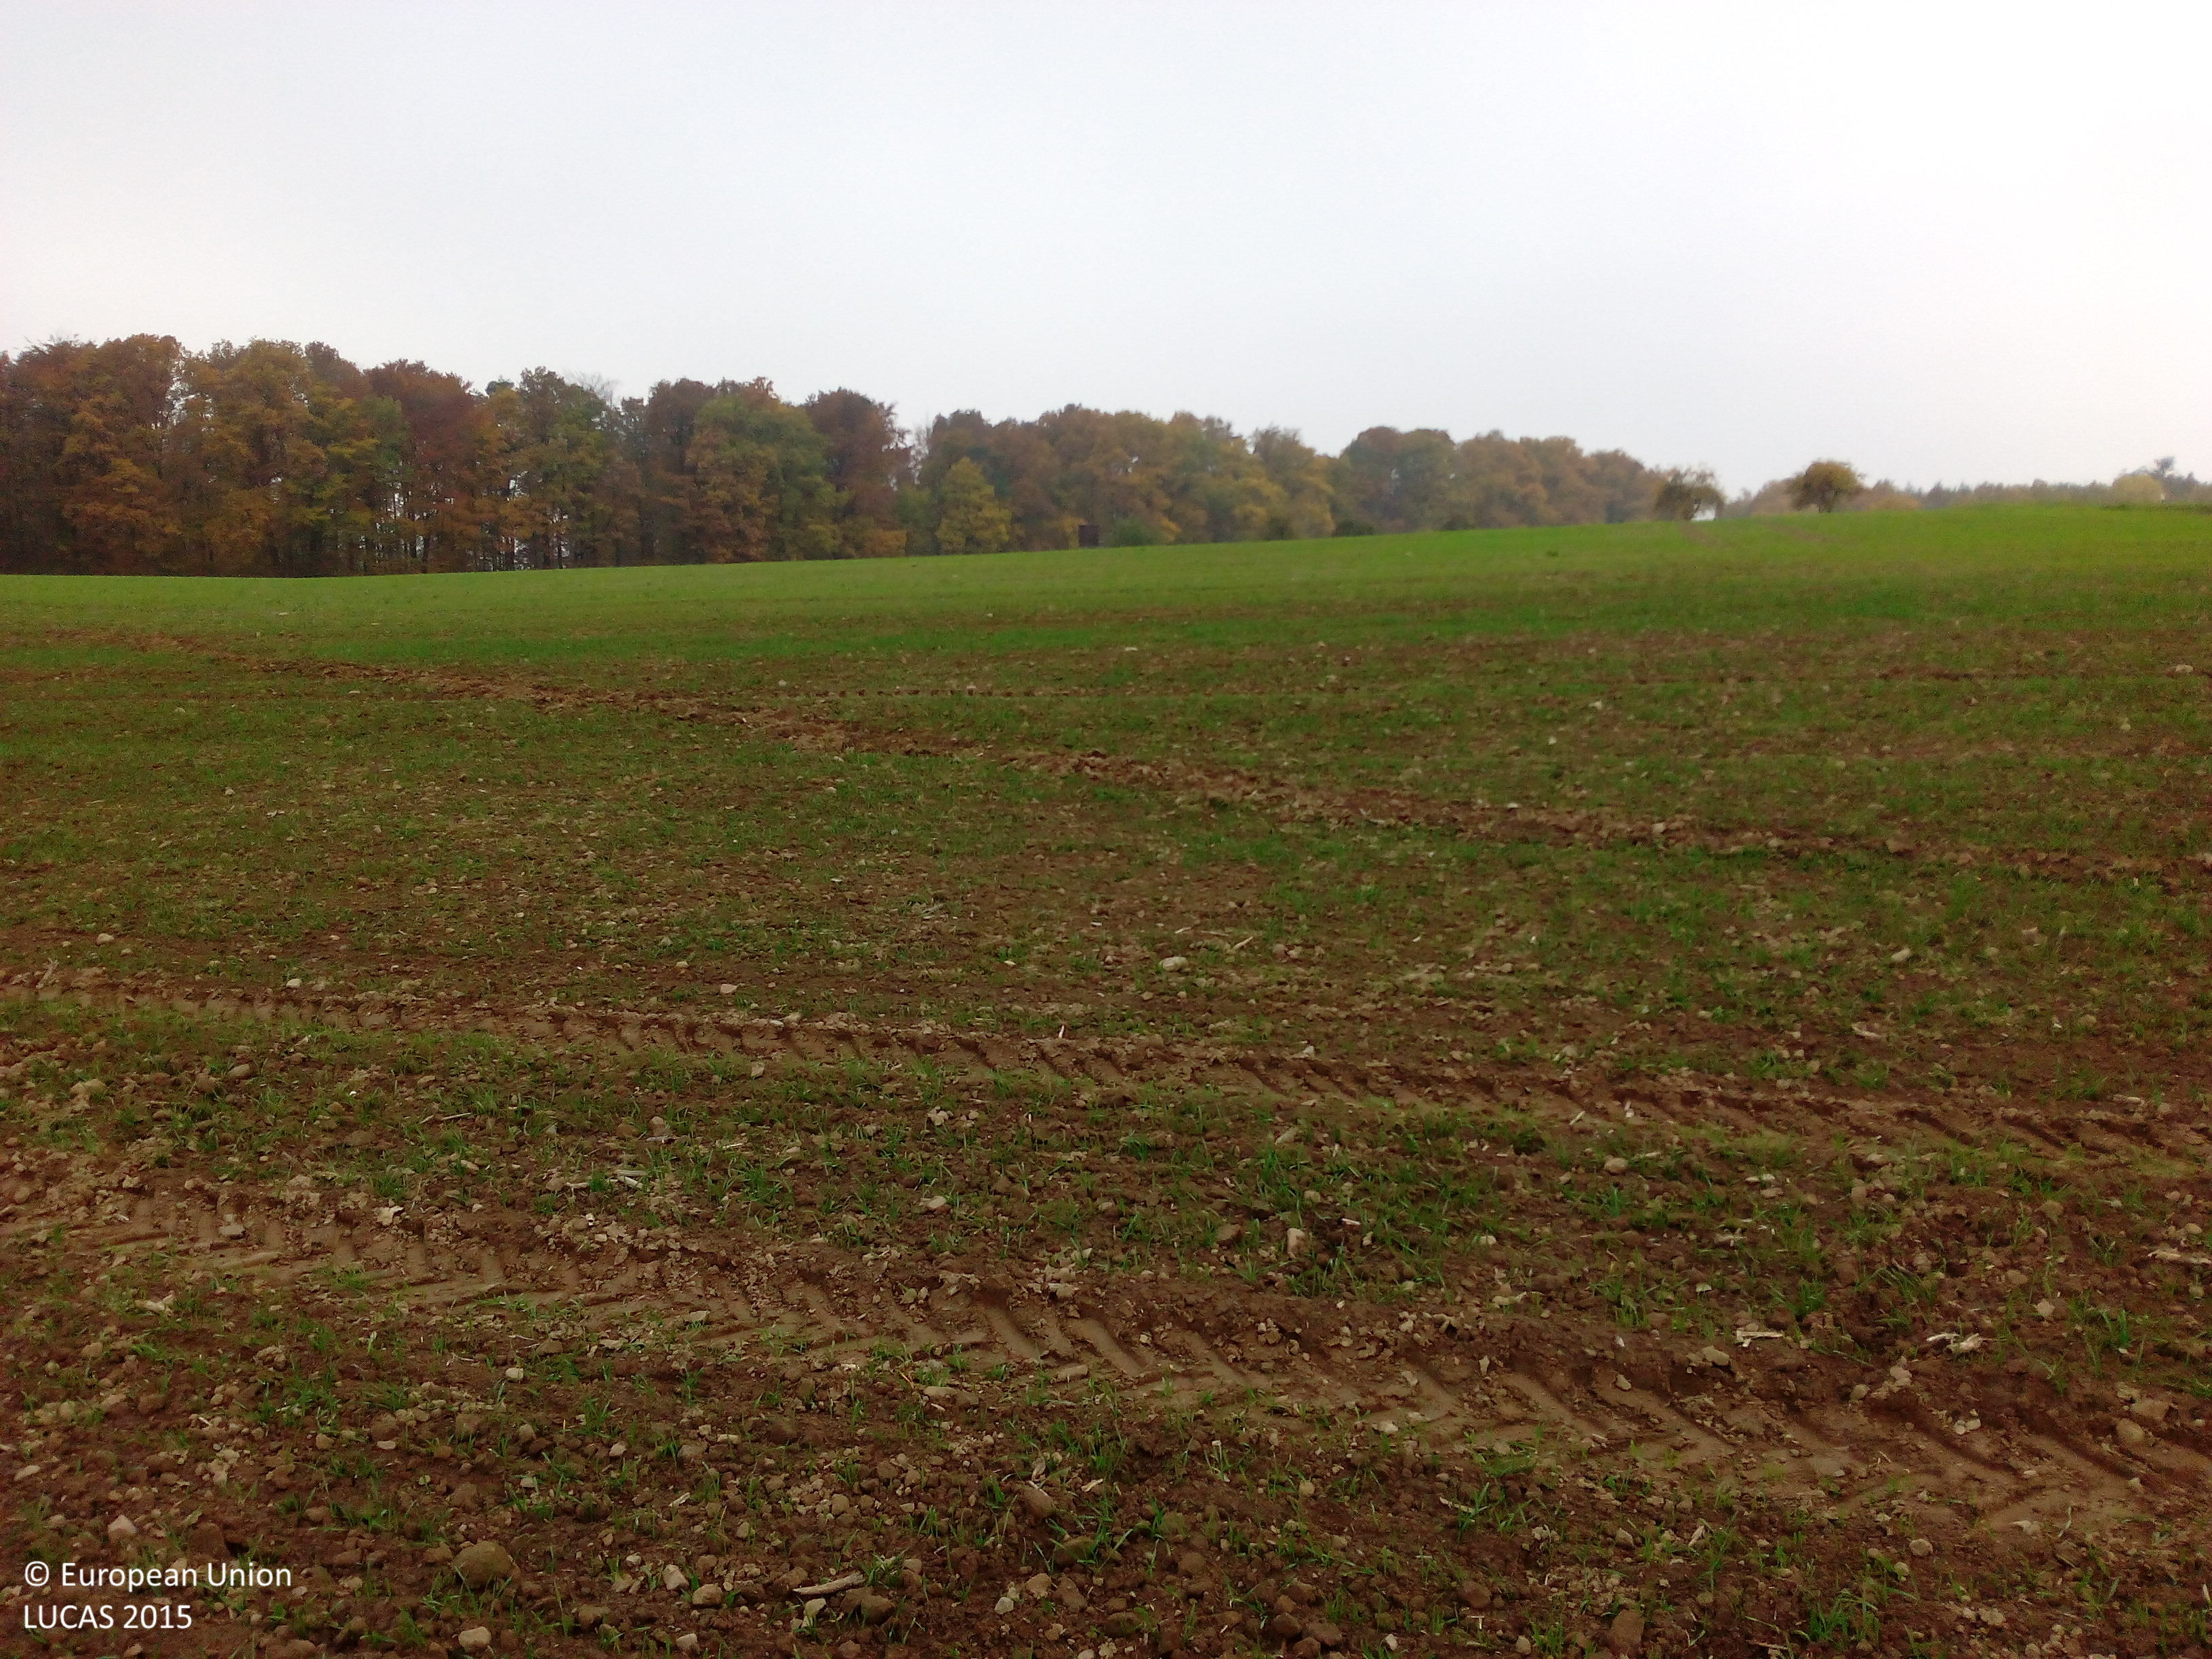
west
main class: Cropland
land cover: Common wheat
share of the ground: < 10 %
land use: Agriculture (excluding fallow land and kitchen gardens)
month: October
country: DE
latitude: 50.2382
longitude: 9.9580
